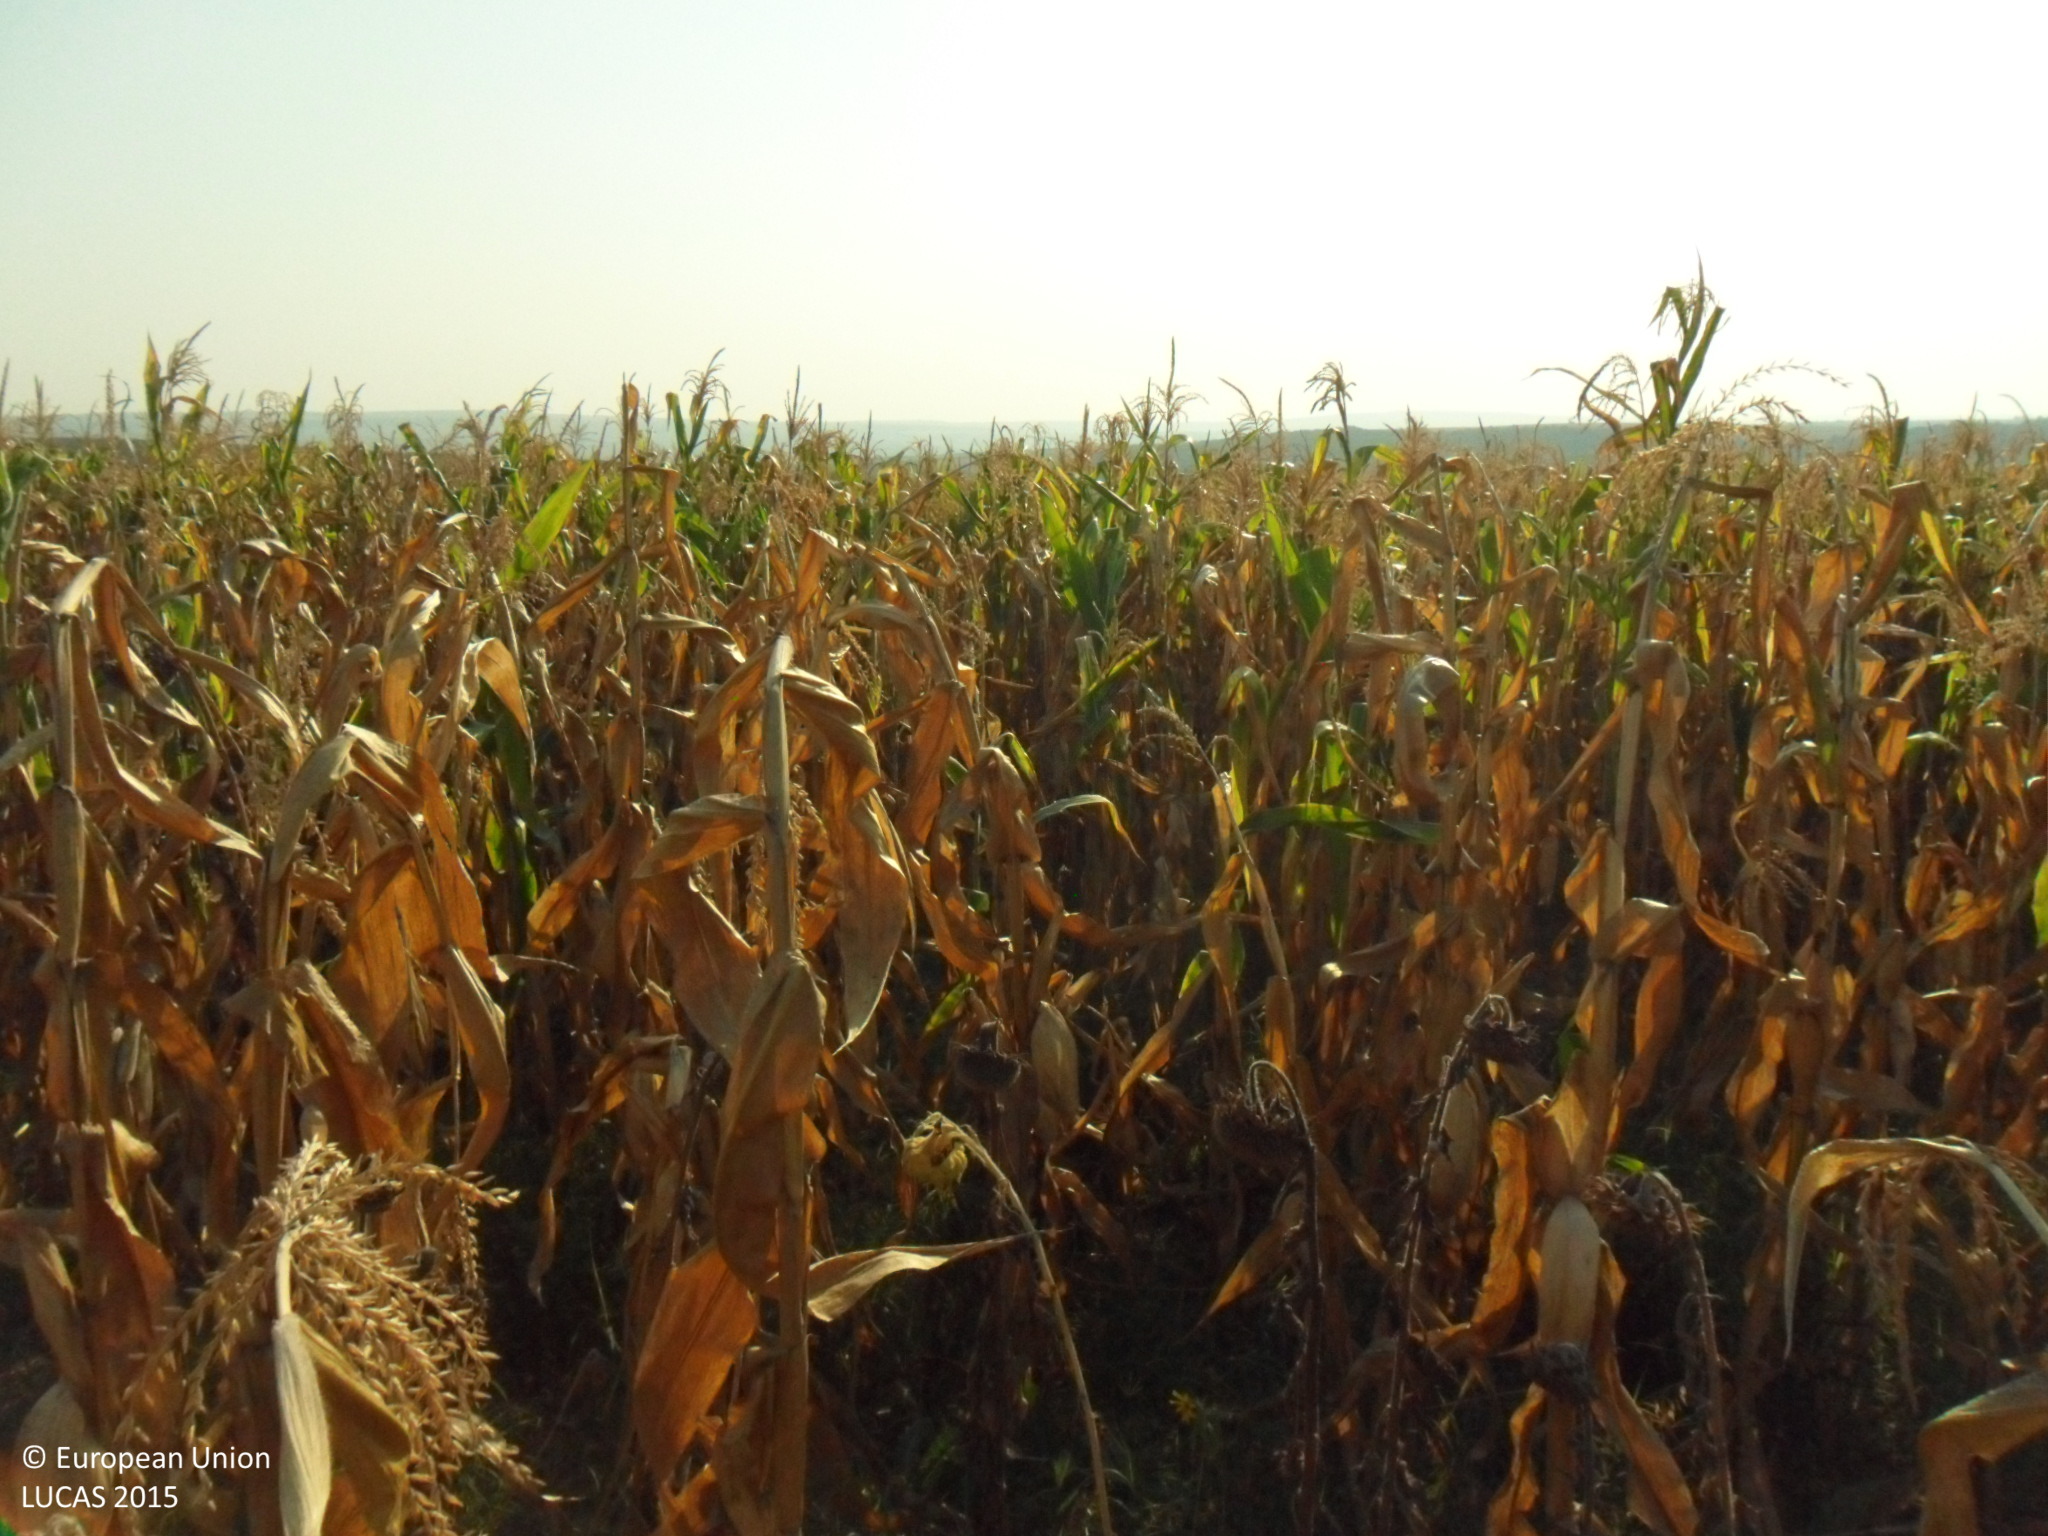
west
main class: Cropland
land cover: Maize
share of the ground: > 75 %
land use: Agriculture (excluding fallow land and kitchen gardens)
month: September
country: BG
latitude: 43.5524
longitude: 26.6080
